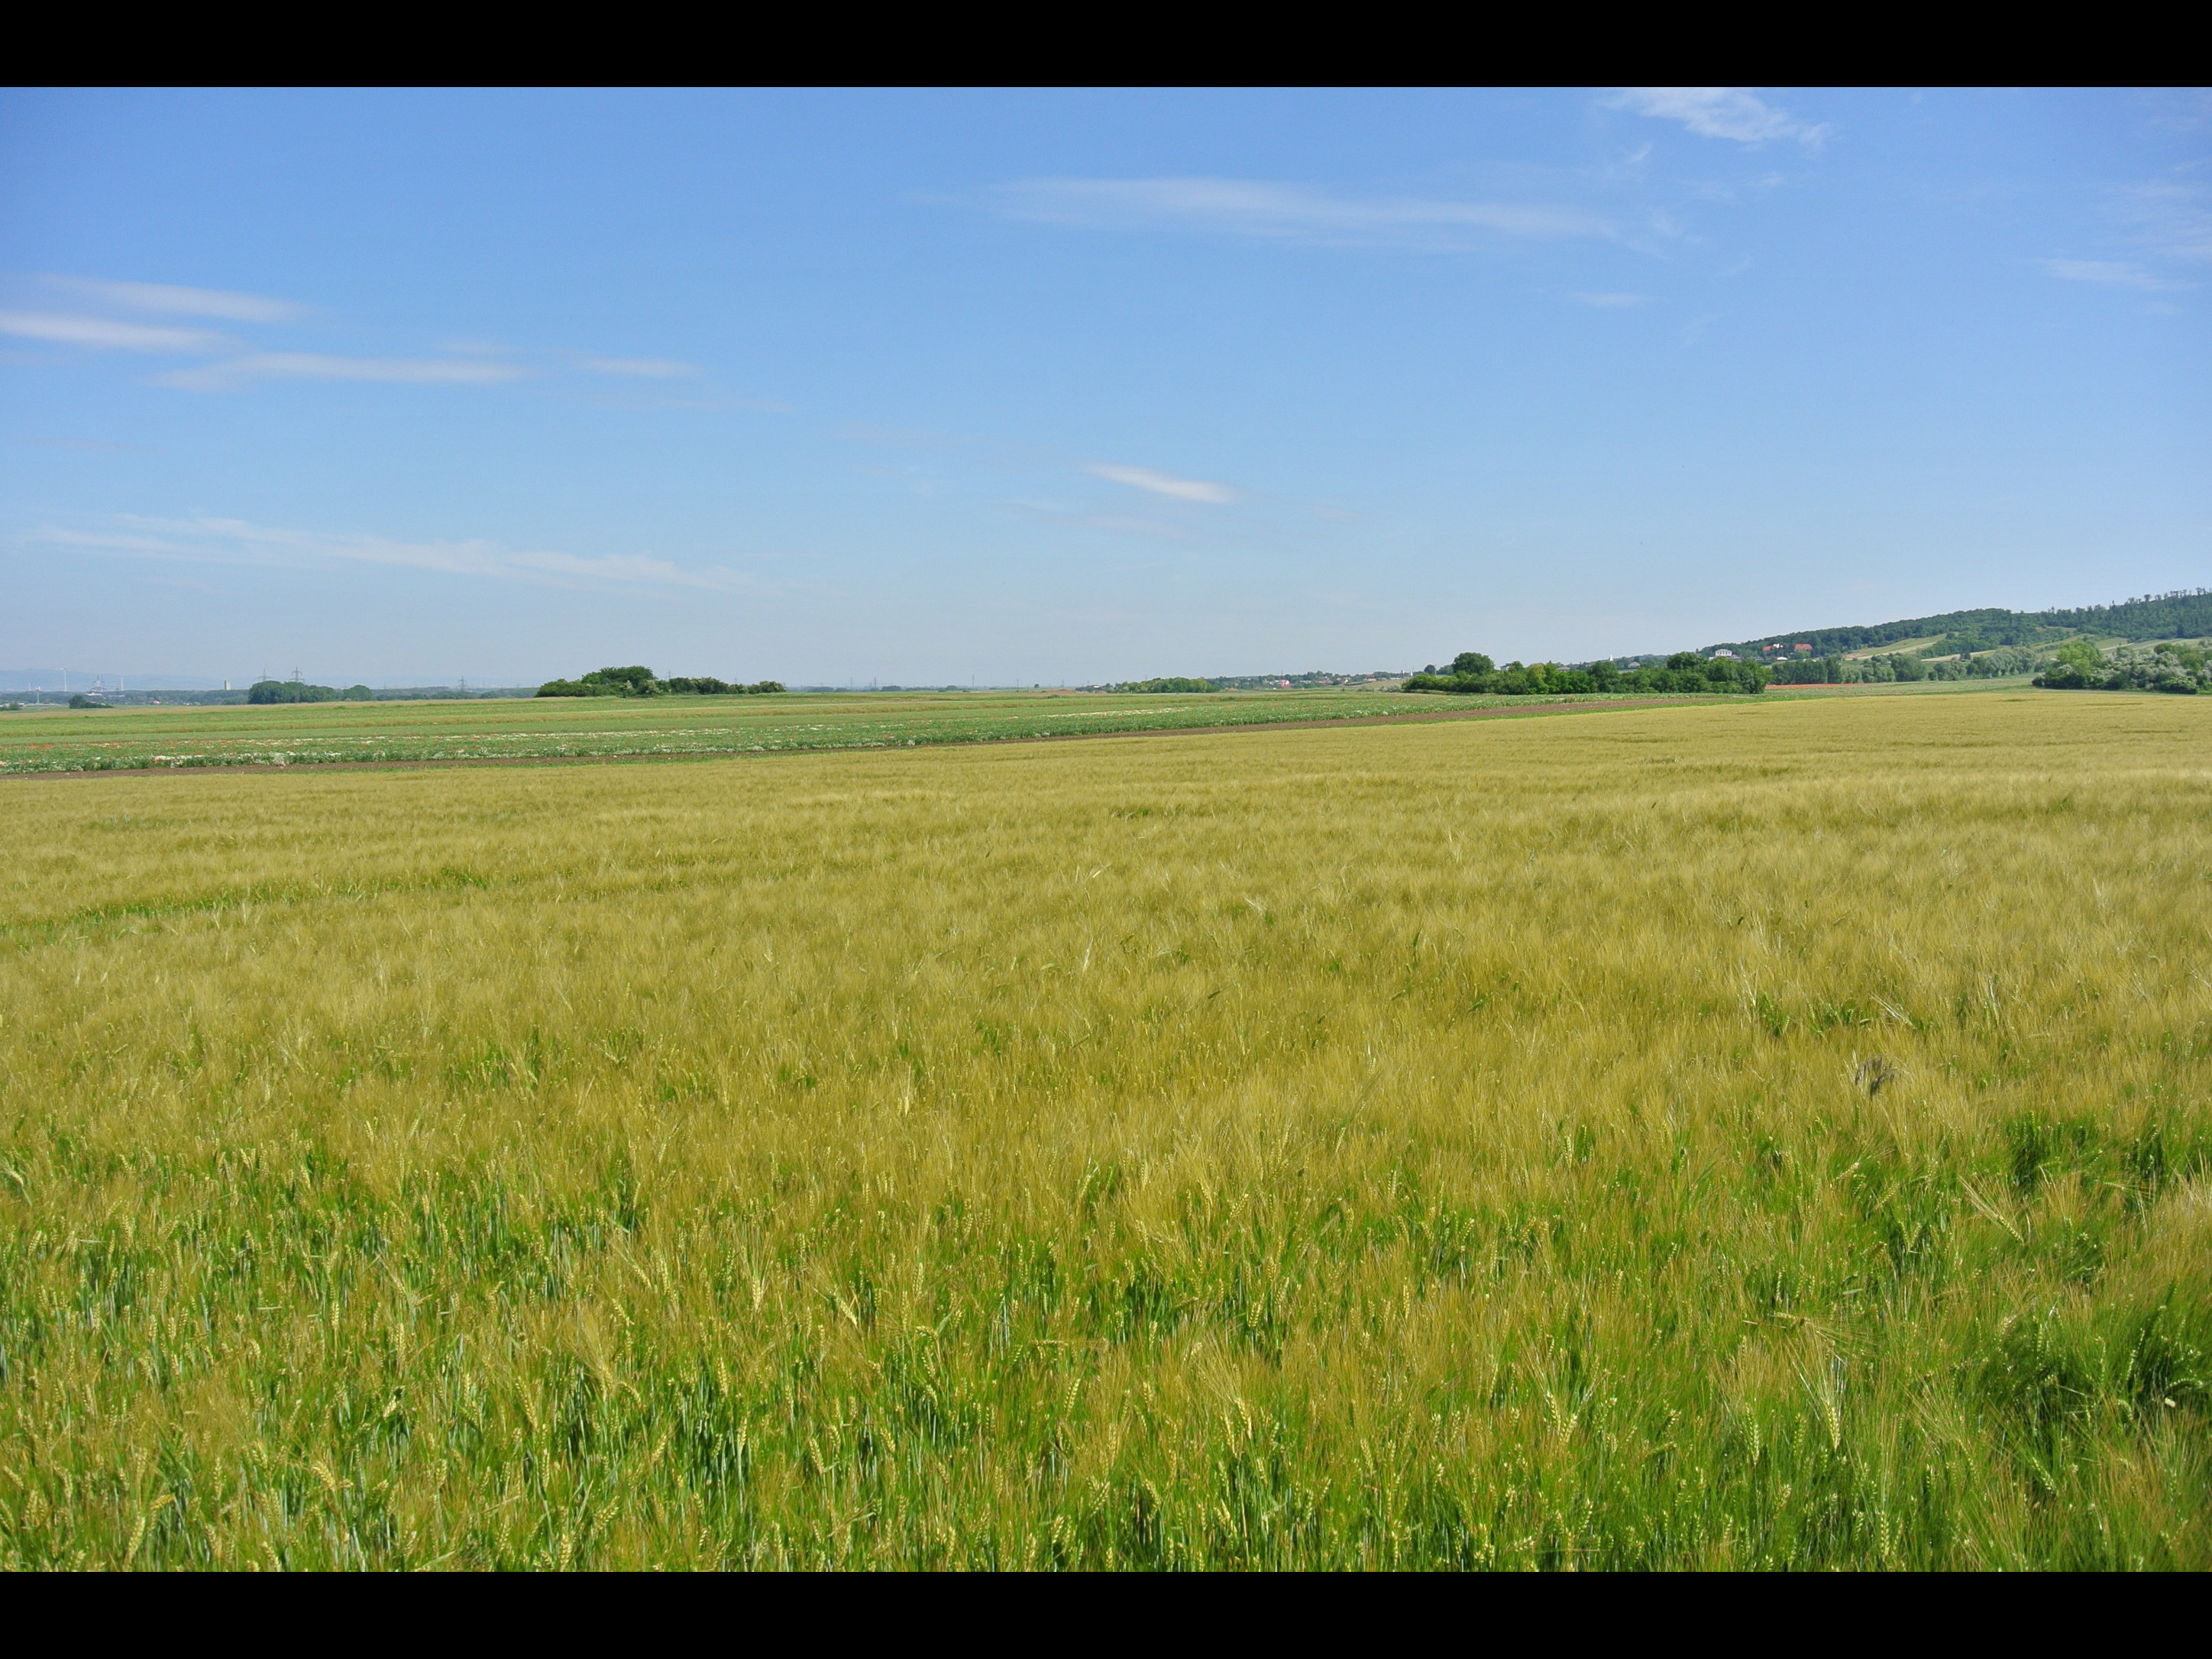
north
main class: Cropland
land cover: Barley
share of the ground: > 75 %
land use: Agriculture (excluding fallow land and kitchen gardens)
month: June
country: AT
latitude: 47.8551
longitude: 16.4332
